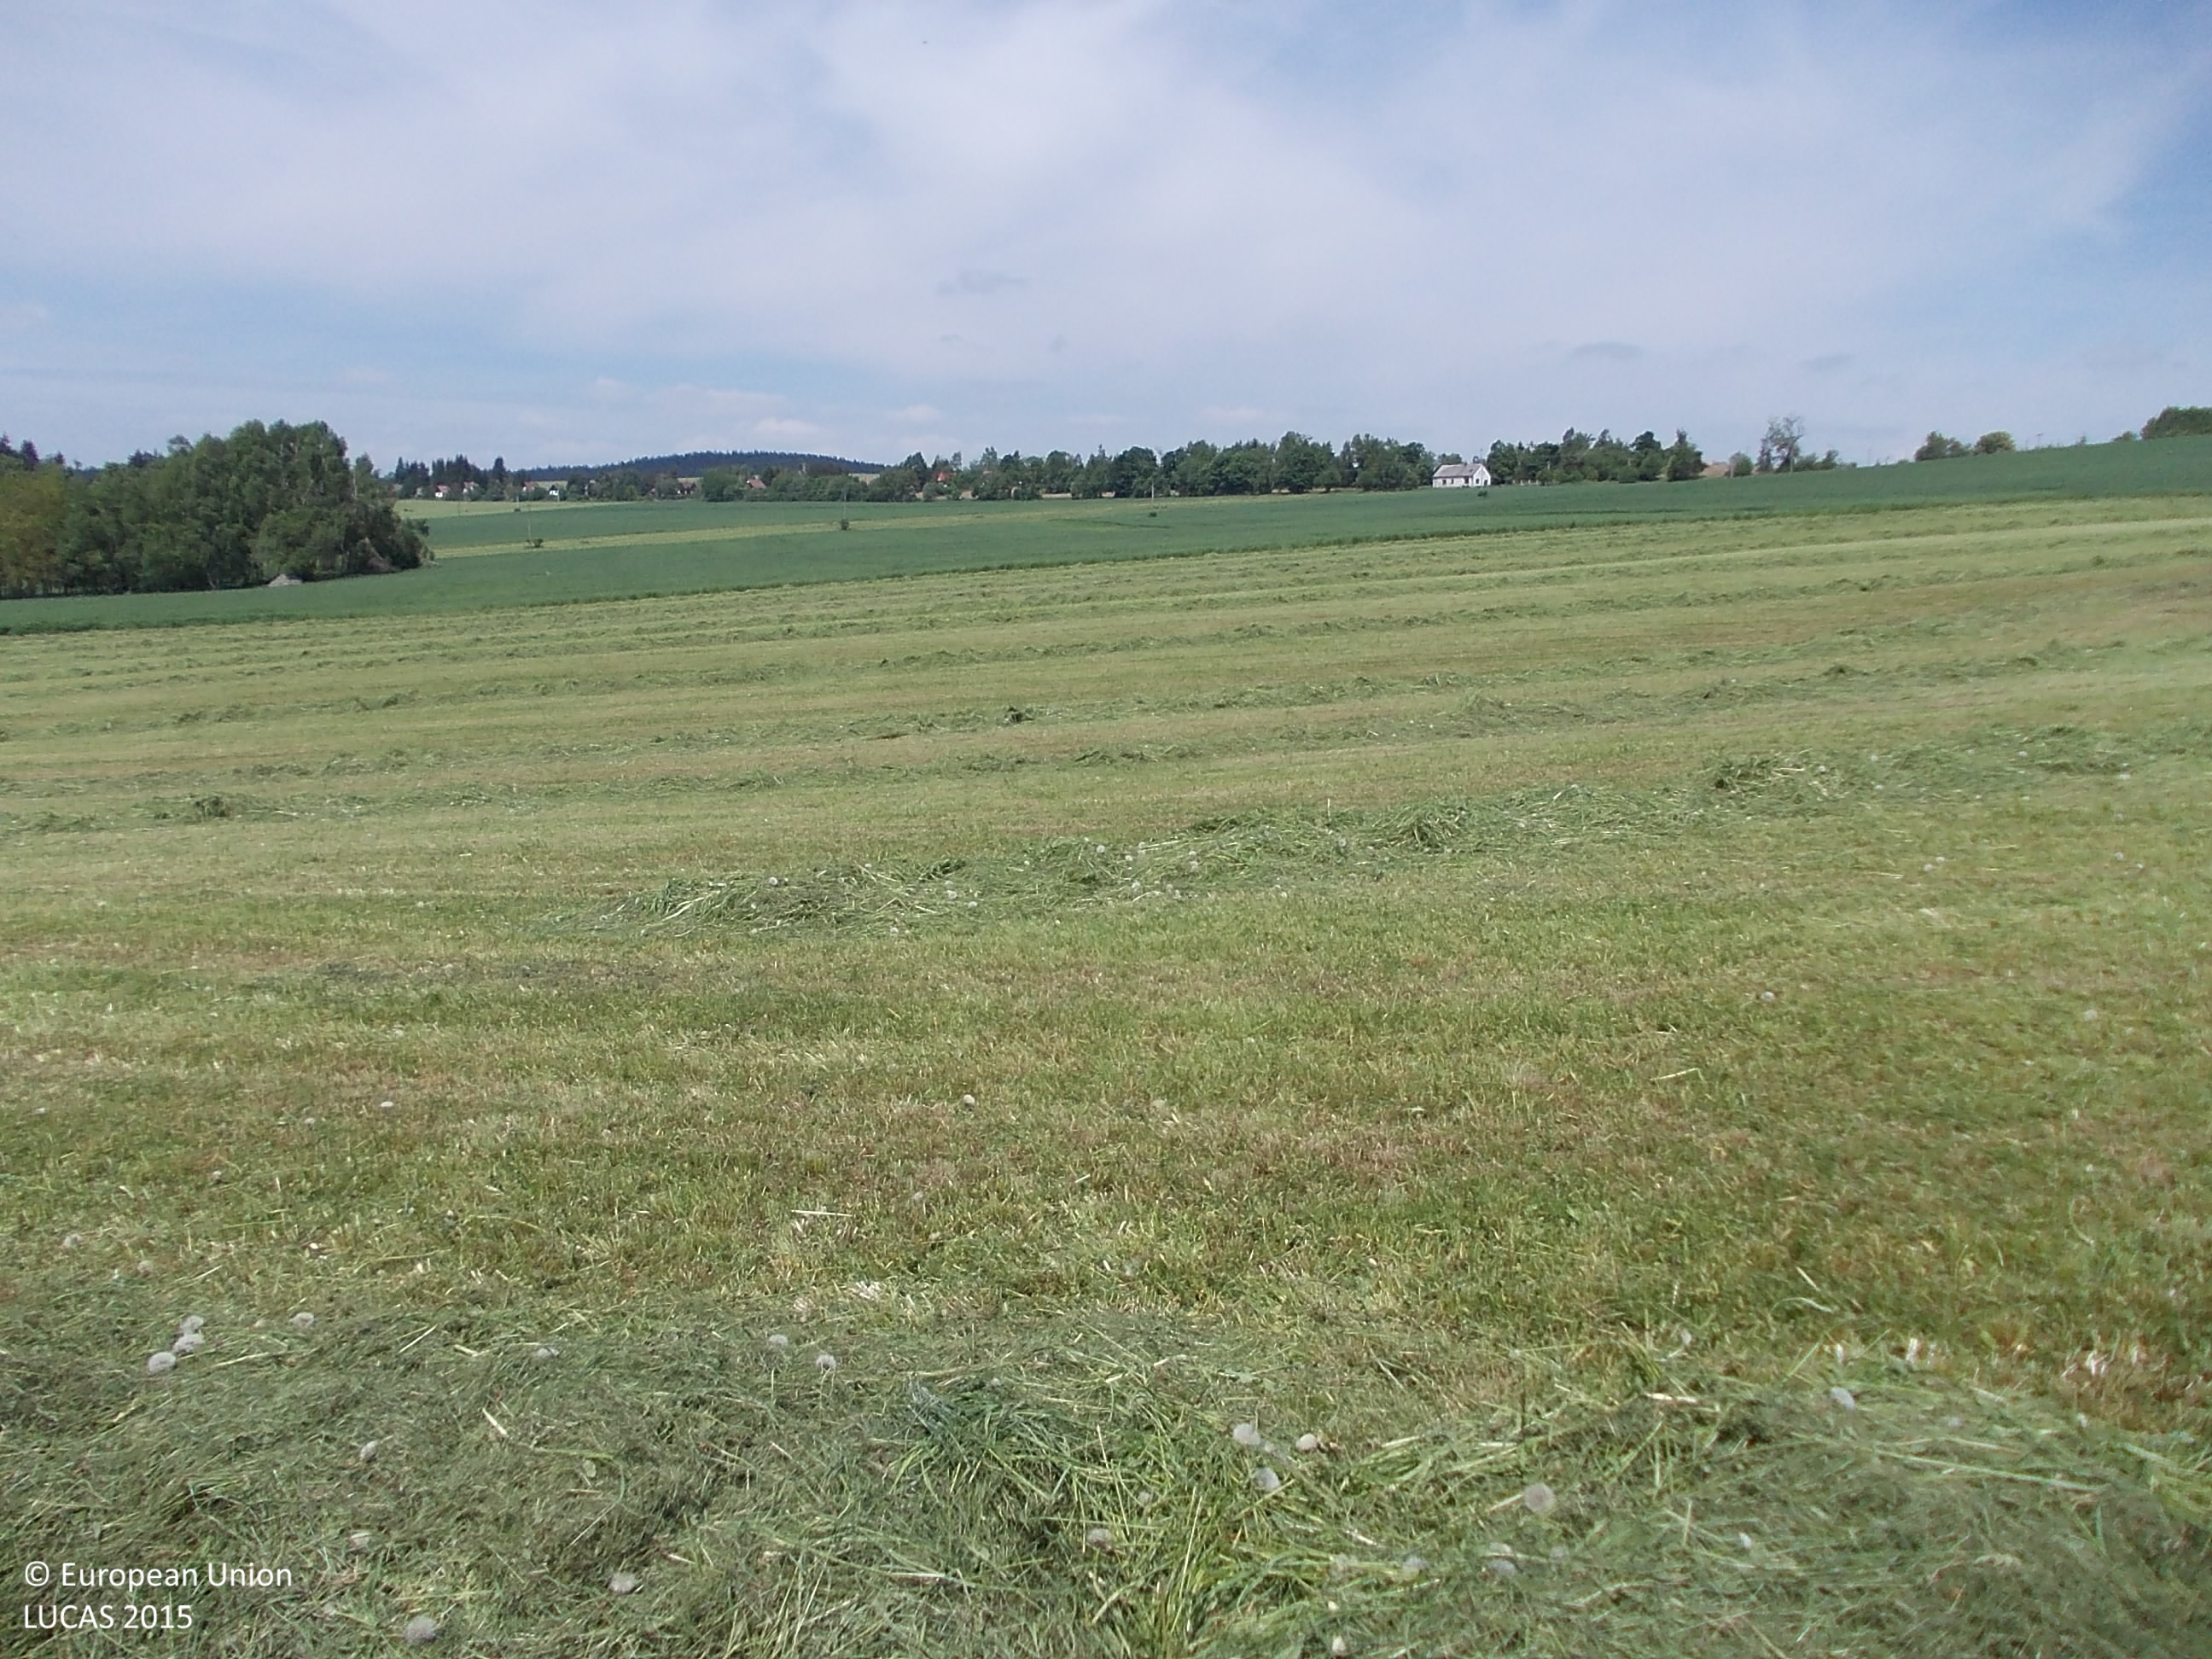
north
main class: Grassland
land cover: Grassland without tree/shrub cover
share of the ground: > 75 %
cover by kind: herbaceous plants 100 %
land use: Agriculture (excluding fallow land and kitchen gardens)
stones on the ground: < 10 %
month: May
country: CZ
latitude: 49.1335
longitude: 13.7144
